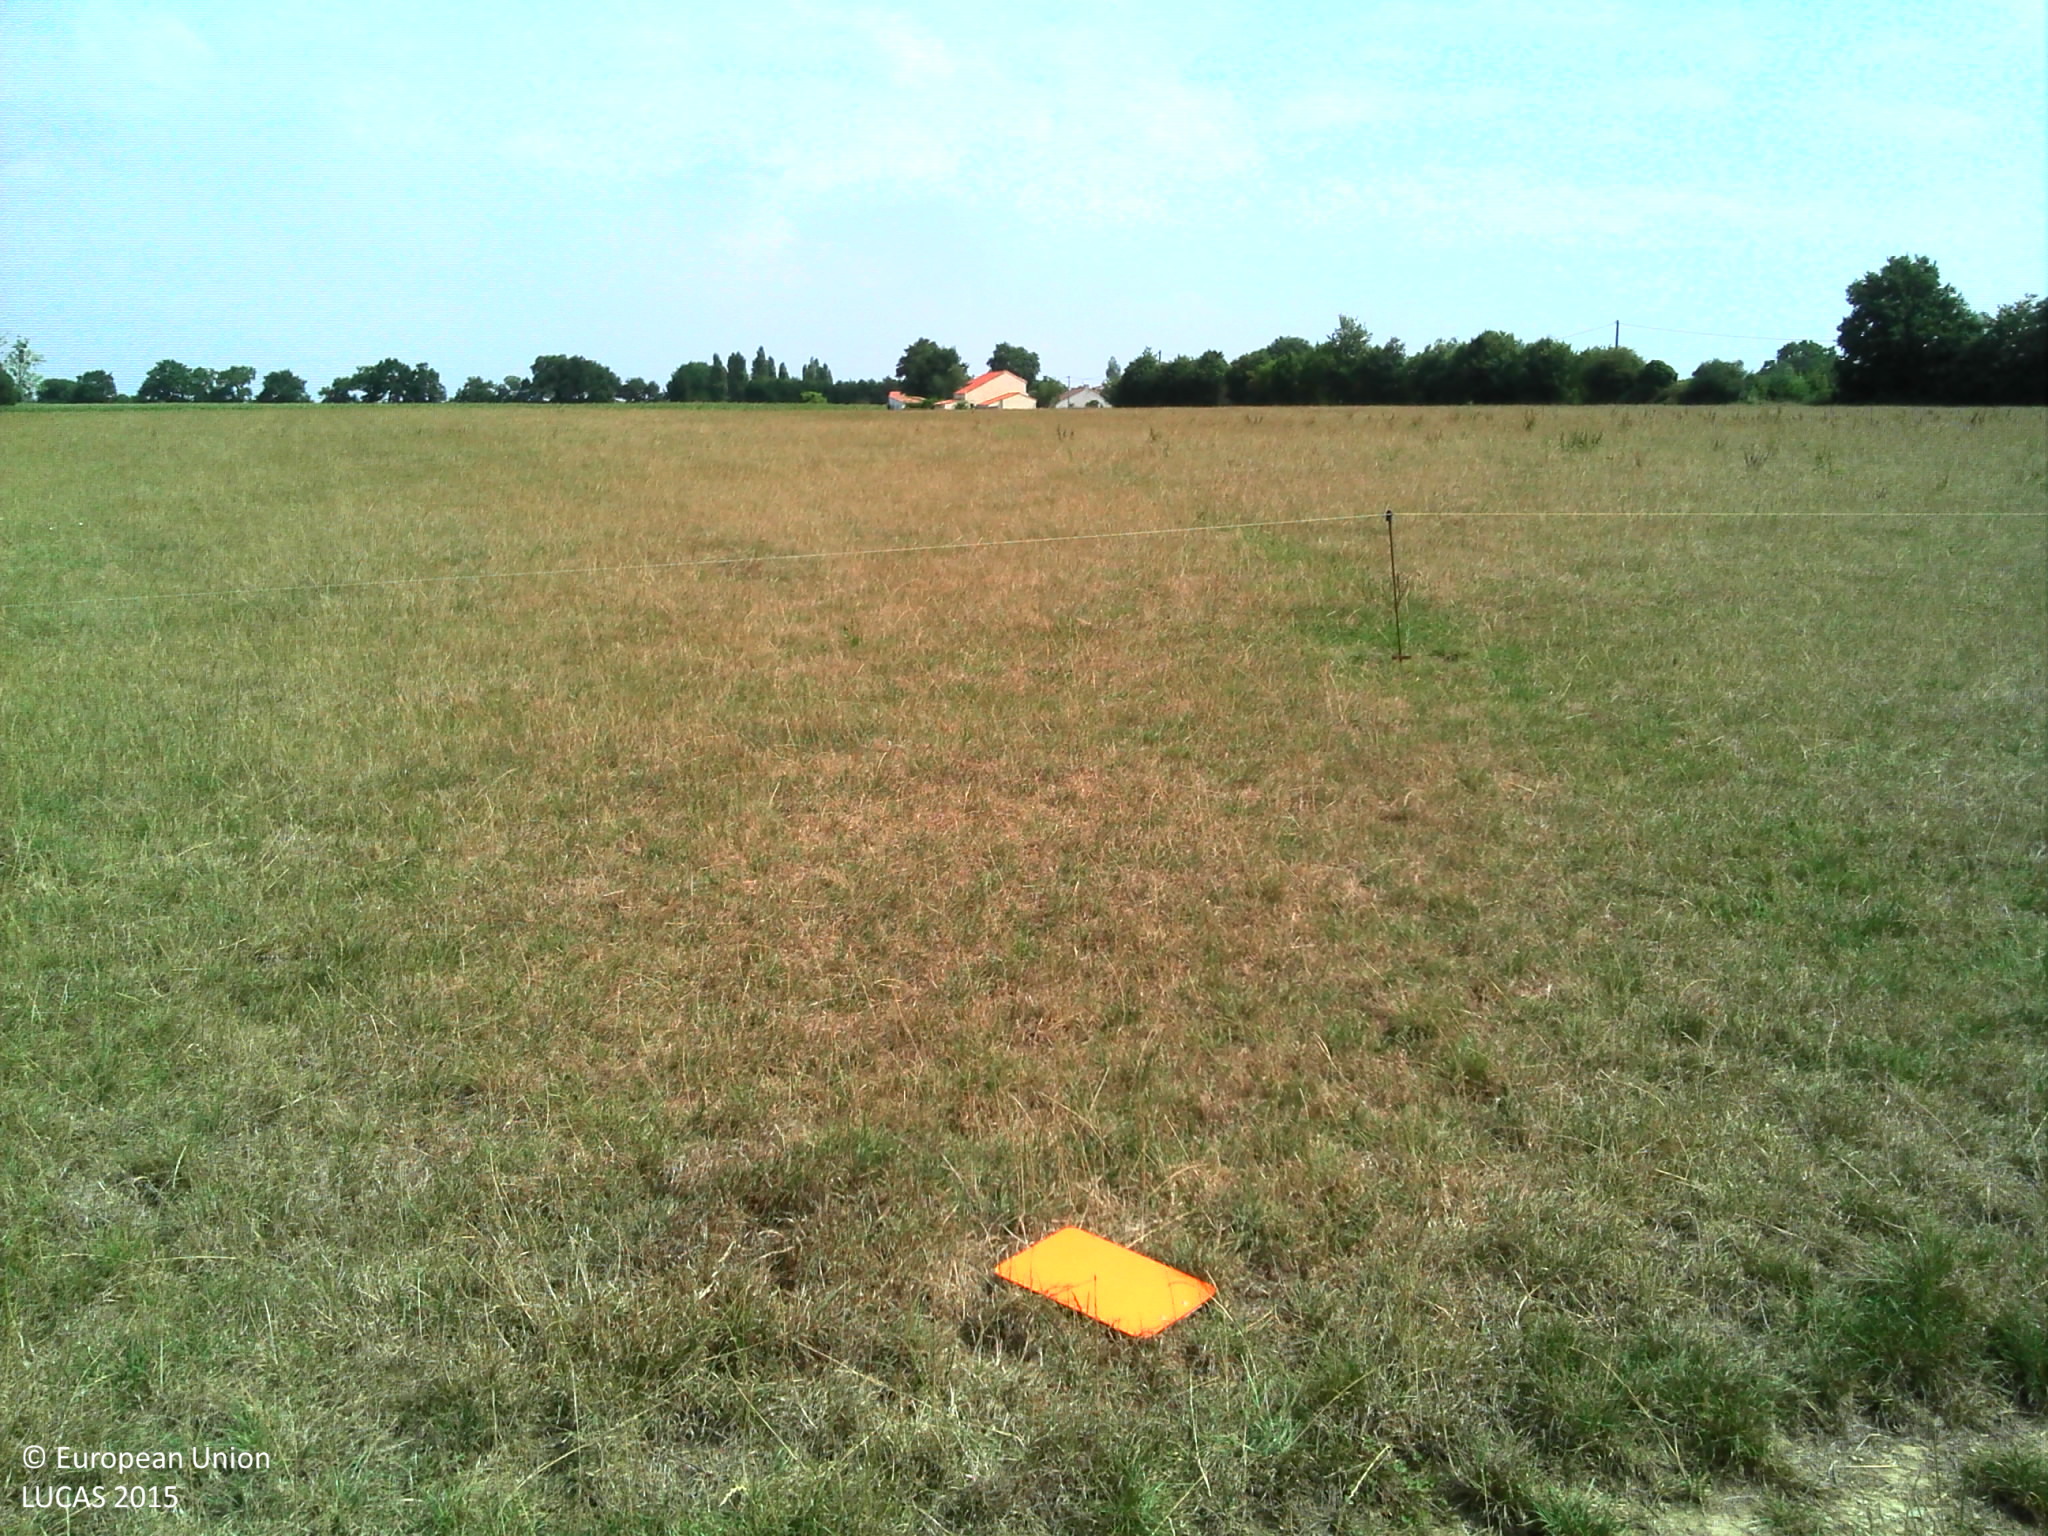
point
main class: Cropland
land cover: Temporary grasslands
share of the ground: > 75 %
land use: Agriculture (excluding fallow land and kitchen gardens)
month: August
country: FR
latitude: 46.9870
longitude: -1.4654
